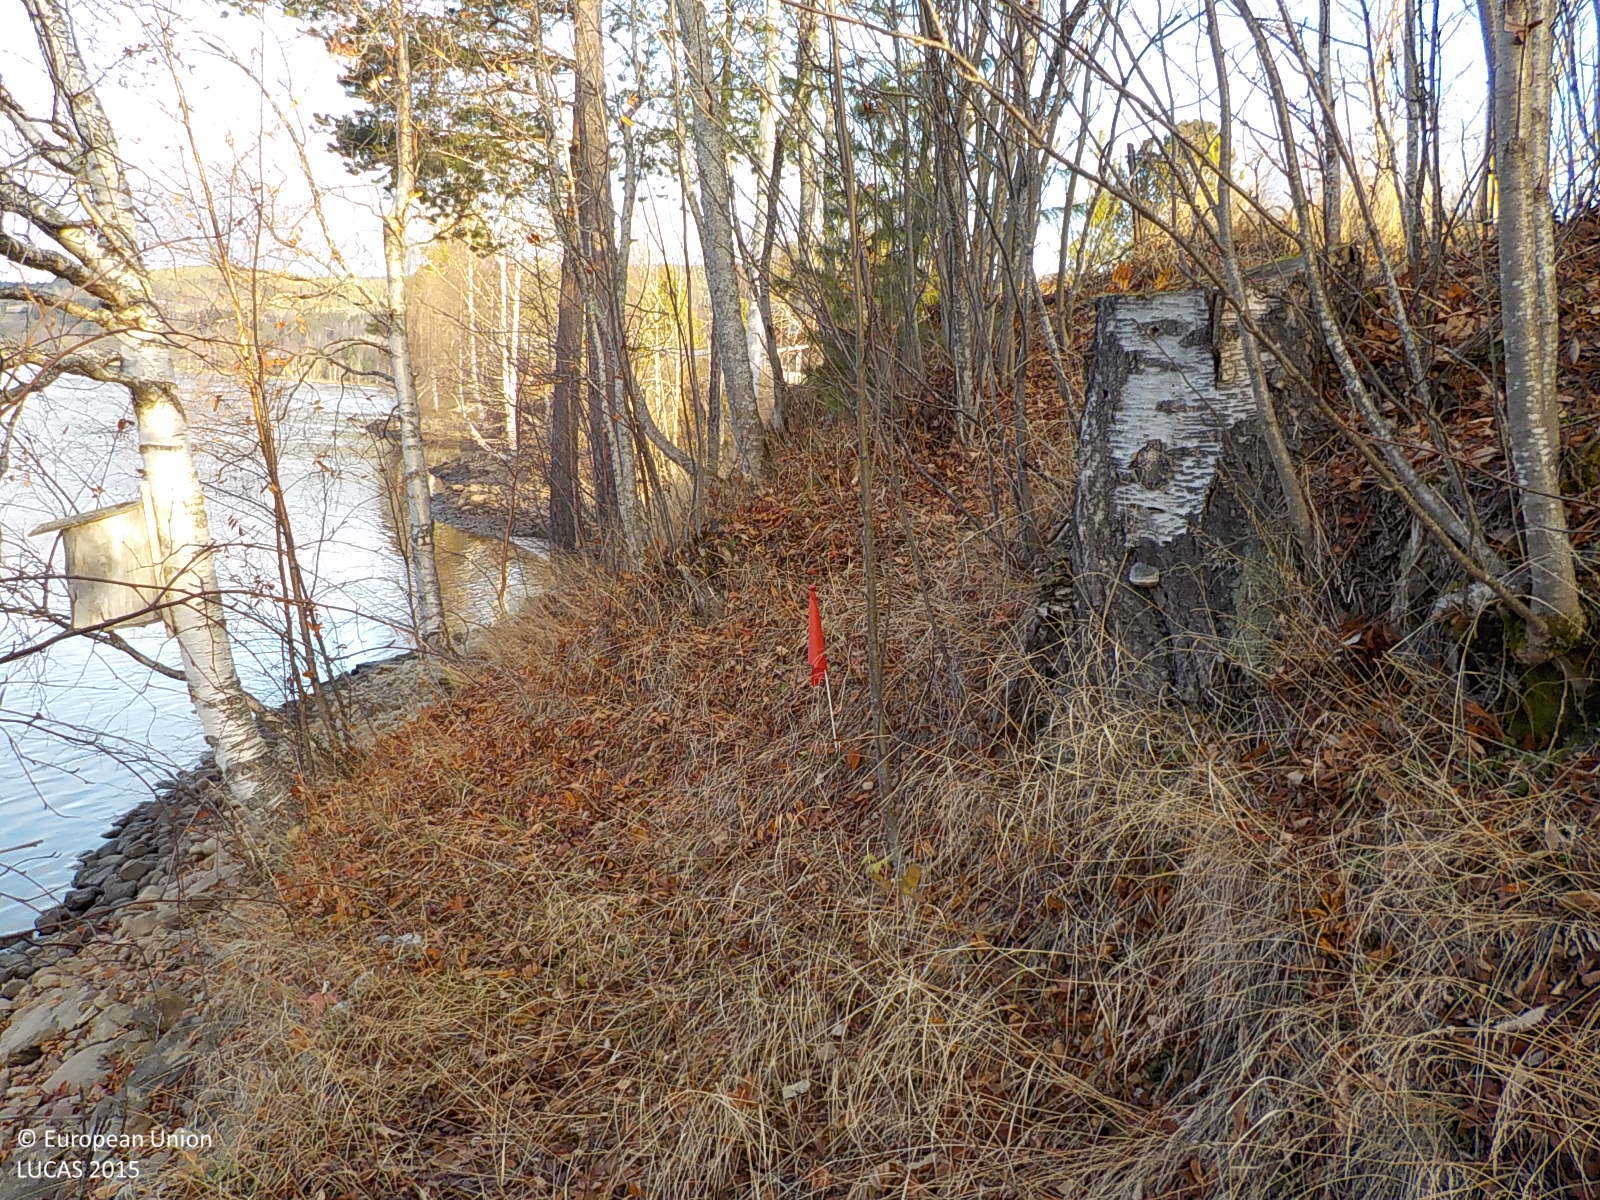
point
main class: Woodland
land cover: Broadleaved woodland
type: boreal forest
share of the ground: > 75 %
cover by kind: broadleaved forest trees 90 %, herbaceous plants 10 %
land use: Semi-natural and natural areas not in use
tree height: > 5 m
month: October
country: SE
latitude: 63.3342
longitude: 17.0648
